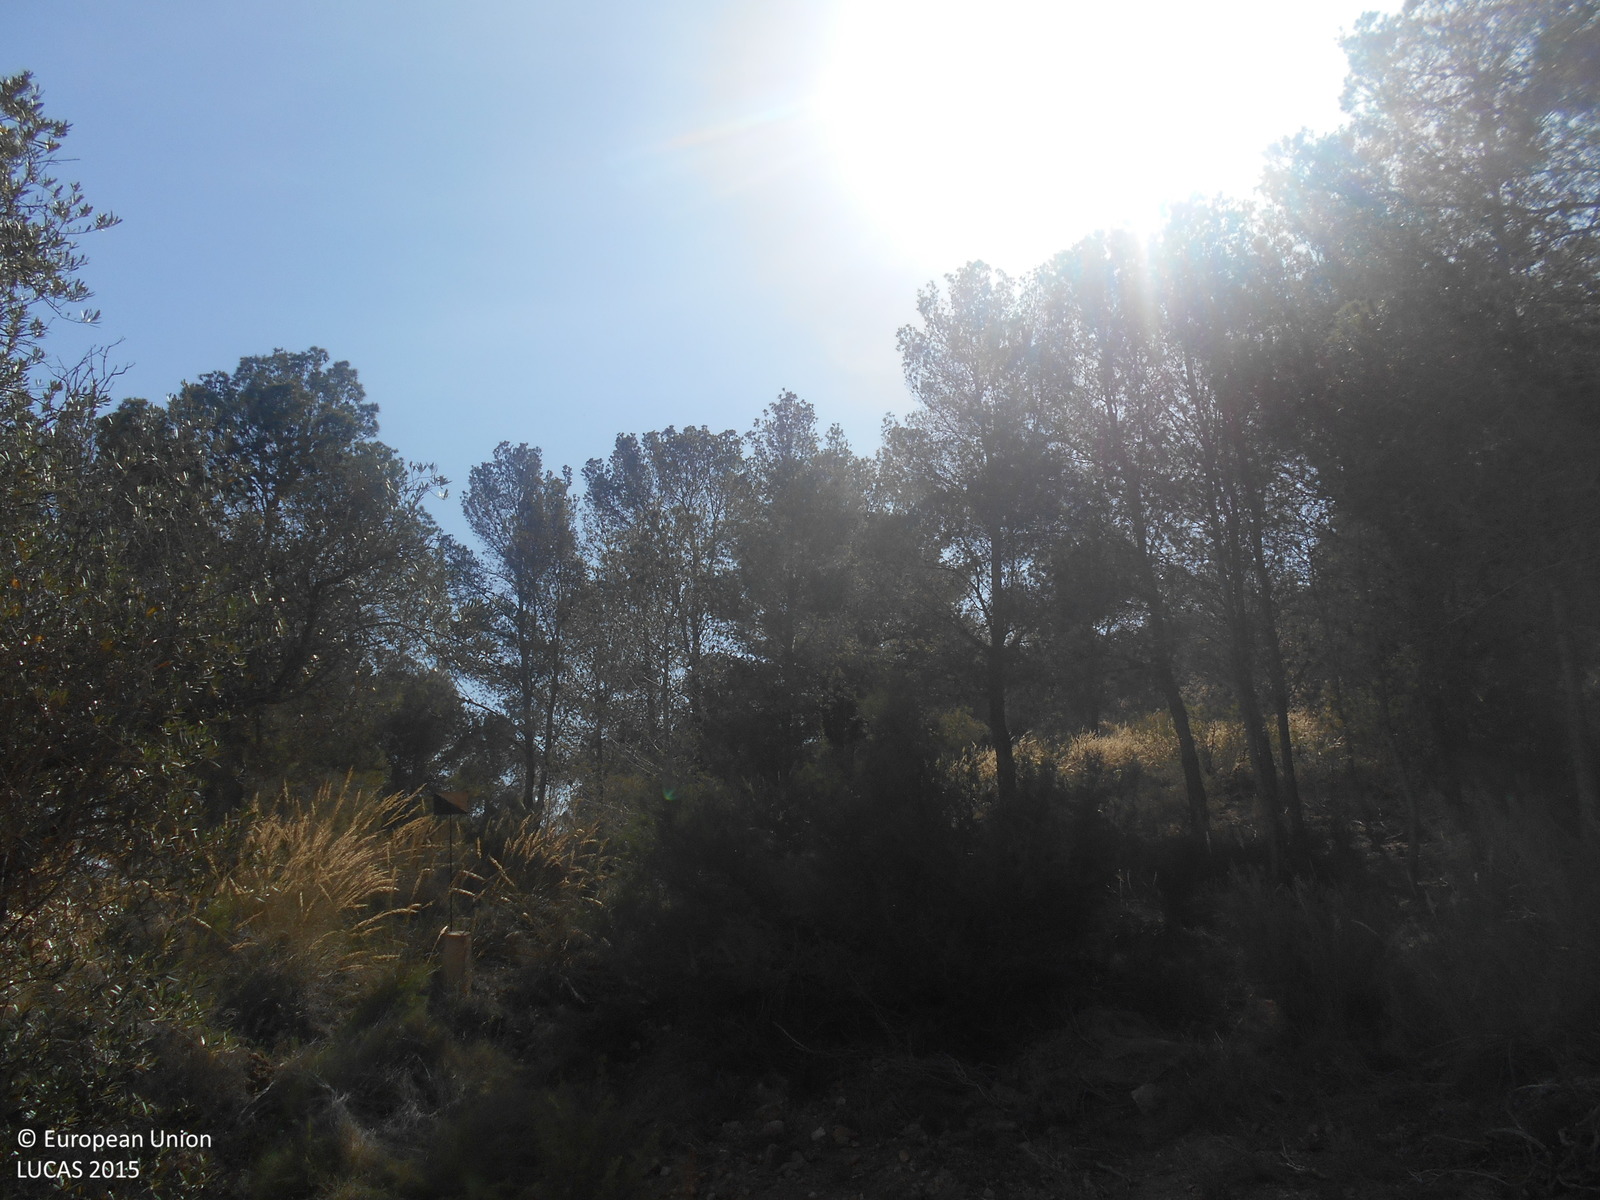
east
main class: Woodland
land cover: Pine dominated coniferous woodland
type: coniferous forest of the mediterranean region
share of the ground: 10 - 25 %
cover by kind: shrubs 60 %, coniferous forest trees 20 %, herbaceous plants 10 %, unconsolidated bare surface 10 %
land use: Semi-natural and natural areas not in use
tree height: > 5 m
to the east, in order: Pine dominated coniferous woodland; Shrubland with sparse tree cover; Shrubland without tree cover; Pine dominated coniferous woodland
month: May
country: ES
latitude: 37.6046
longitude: -1.4323
